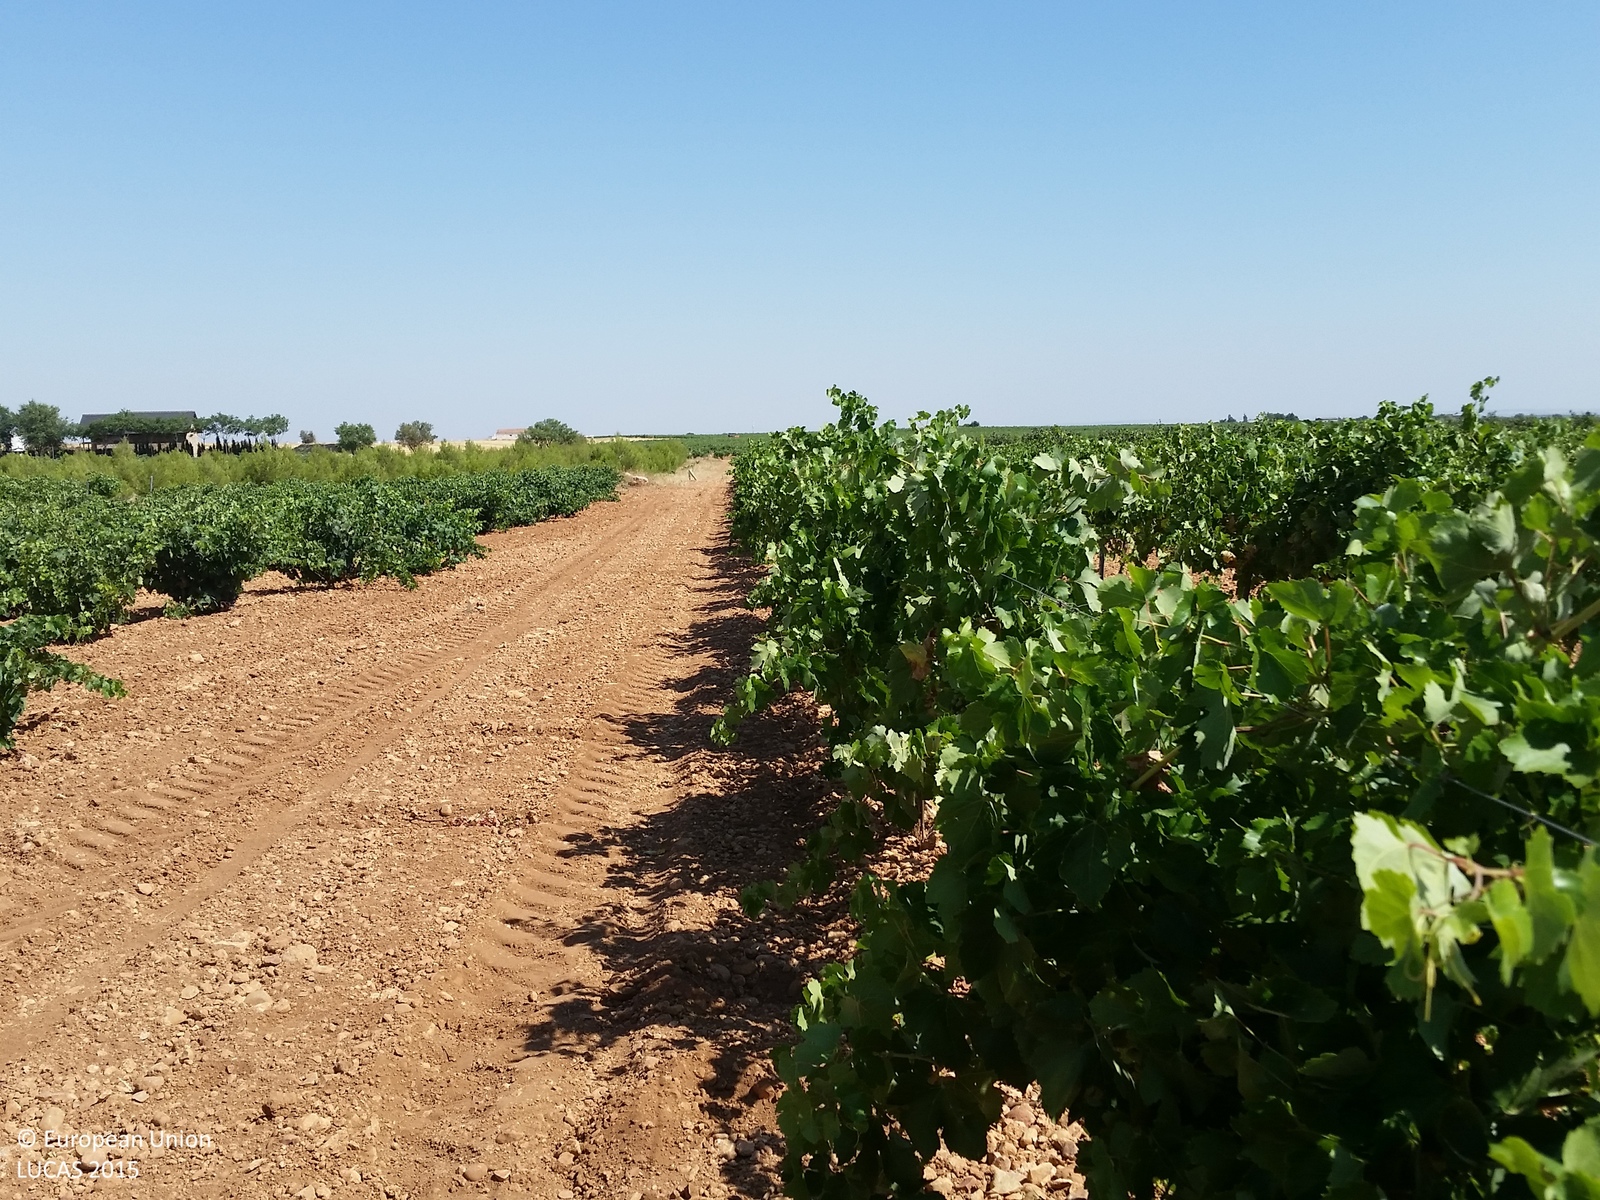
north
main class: Cropland
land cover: Vineyards
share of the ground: 50 - 75 %
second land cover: Other bare soil
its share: > 75 %
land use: Agriculture (excluding fallow land and kitchen gardens)
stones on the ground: 10 - 25 %
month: July
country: ES
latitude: 39.2168
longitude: -2.5758
